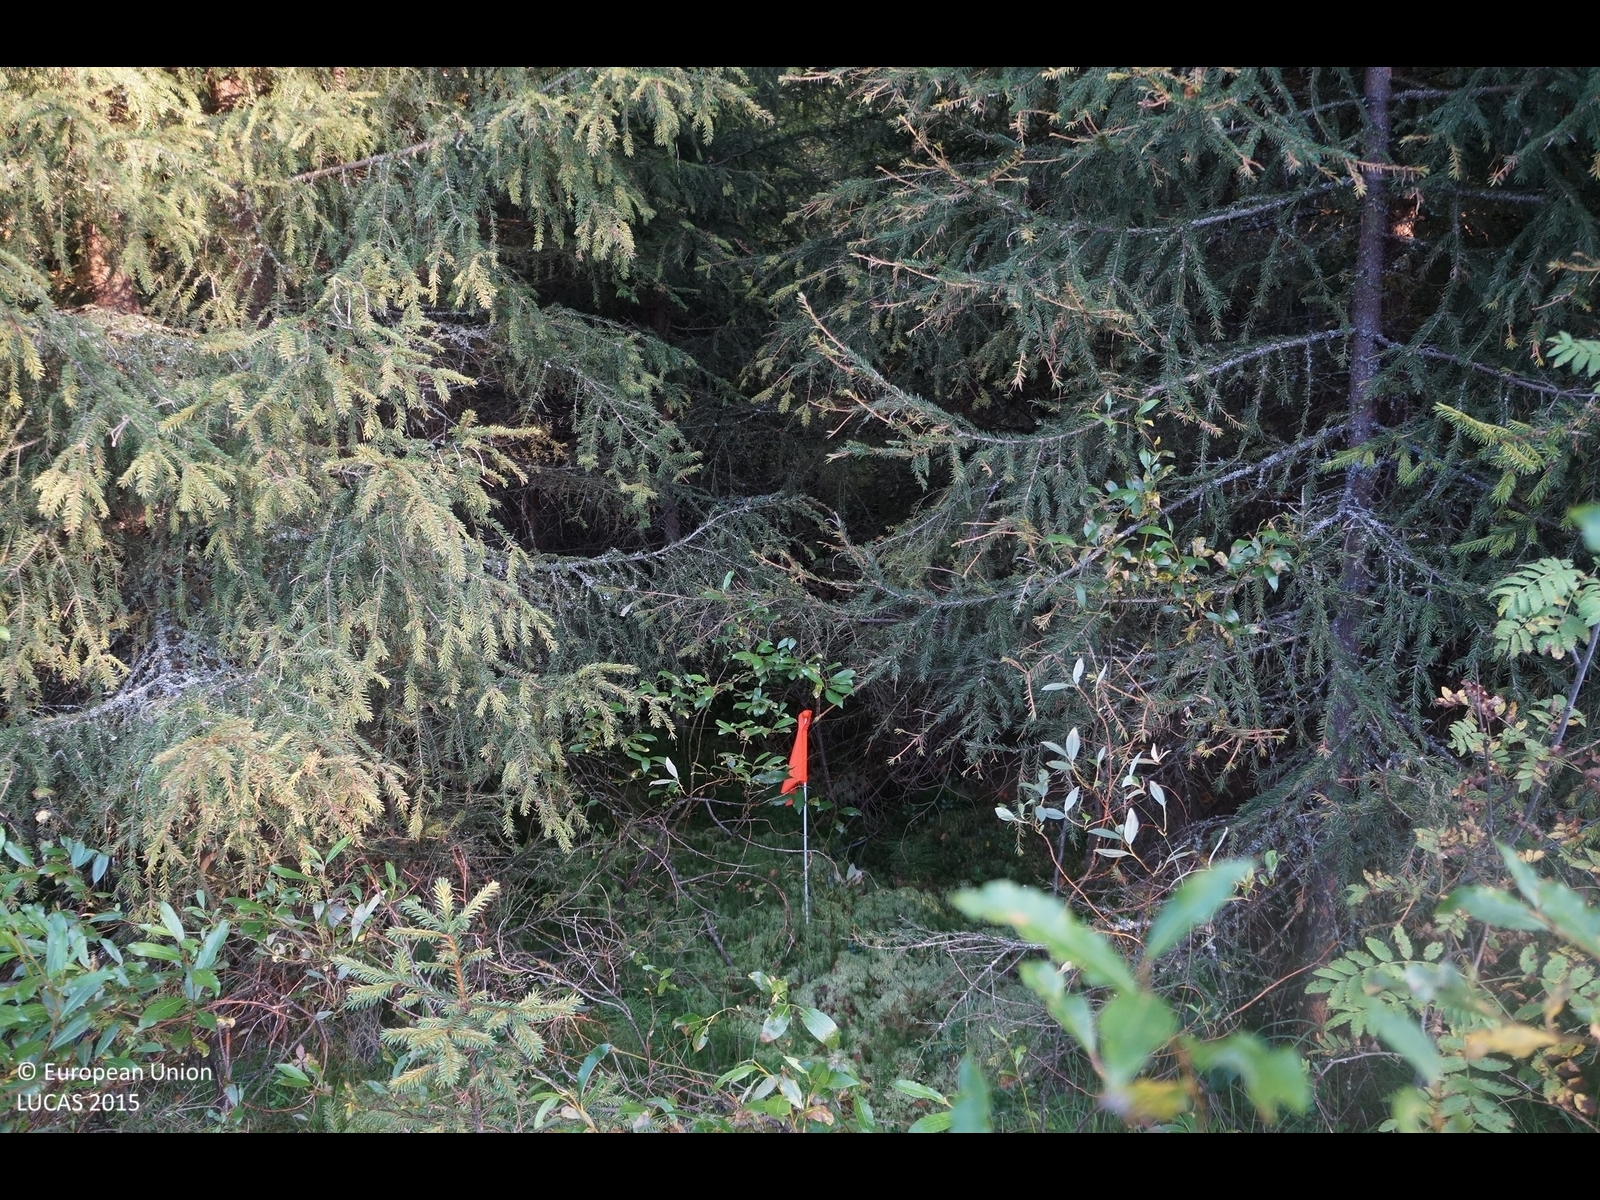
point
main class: Woodland
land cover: Spruce dominated mixed woodland
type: boreal forest
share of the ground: 50 - 75 %
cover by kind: coniferous forest trees 45 %, shrubs 25 %, broadleaved forest trees 20 %, herbaceous plants 5 %, lichens and mosses 5 %
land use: Forestry
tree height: > 5 m
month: August
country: FI
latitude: 64.1563
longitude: 25.0313
